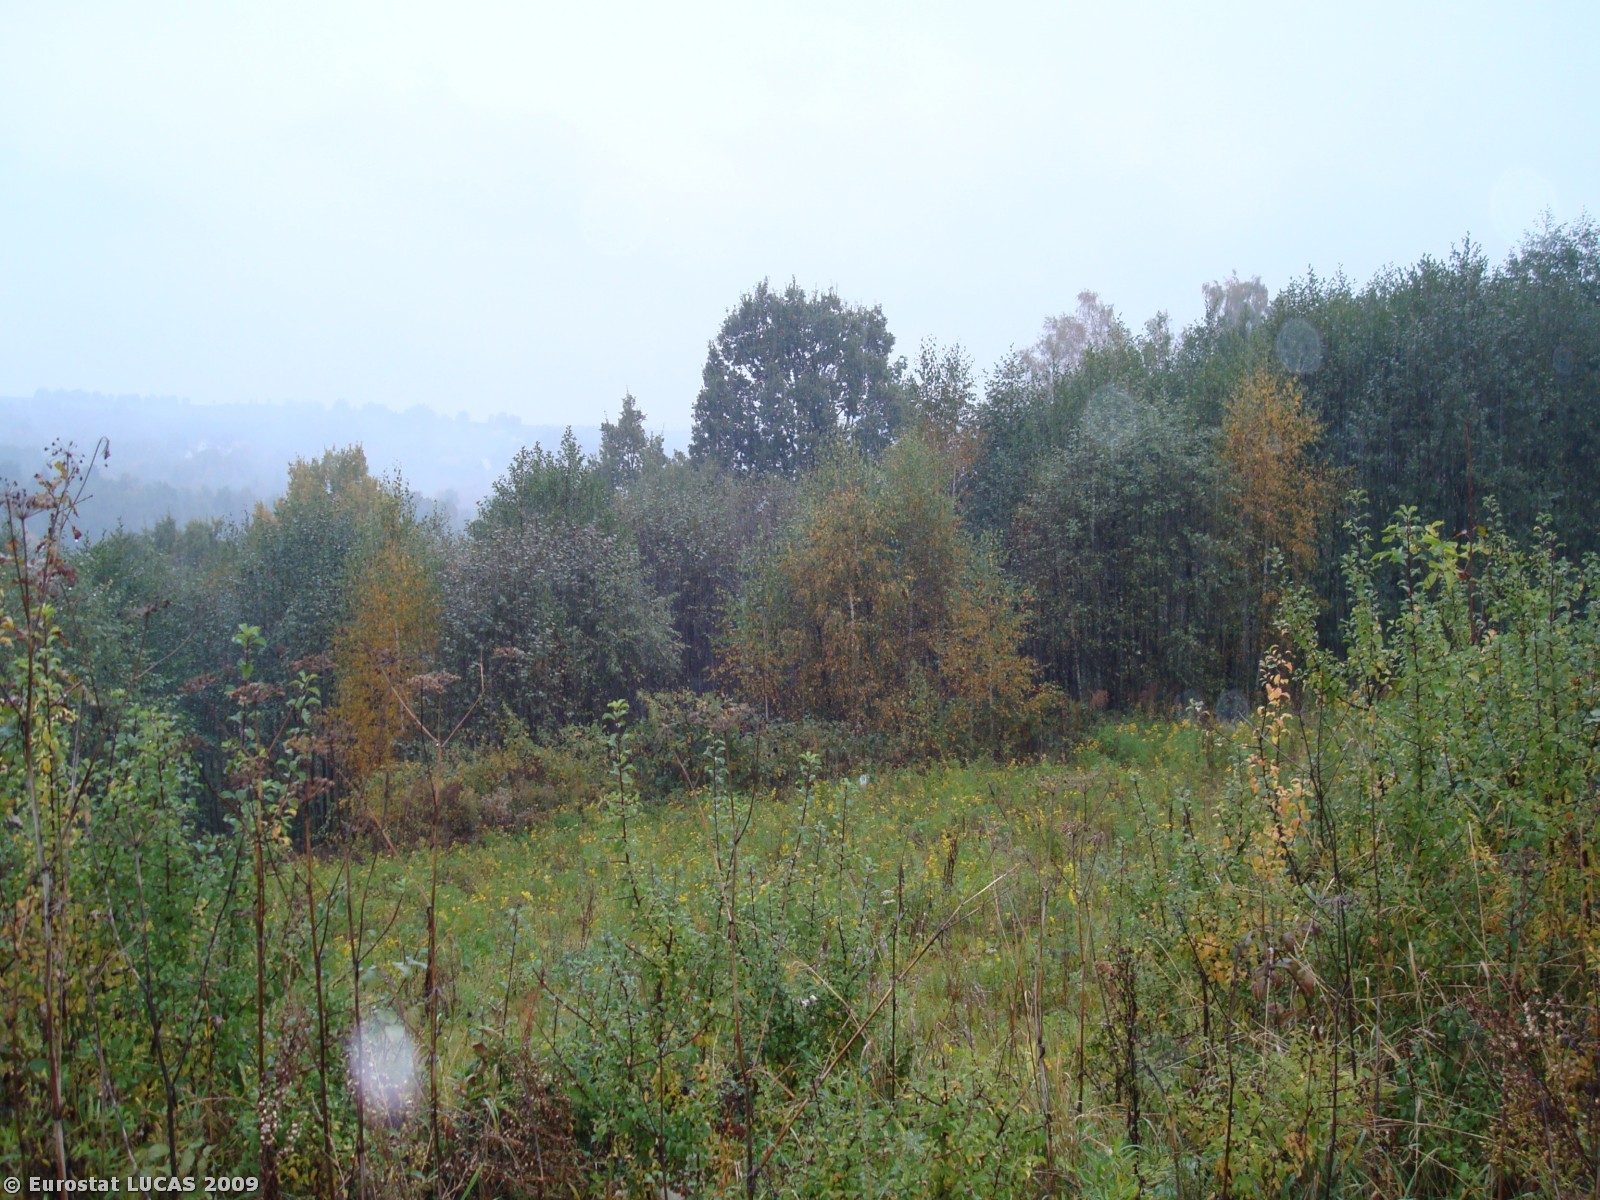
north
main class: Grassland
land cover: Spontaneously vegetated surfaces
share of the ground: > 75 %
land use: Unused
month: September
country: PL
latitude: 49.8320
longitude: 19.6069
